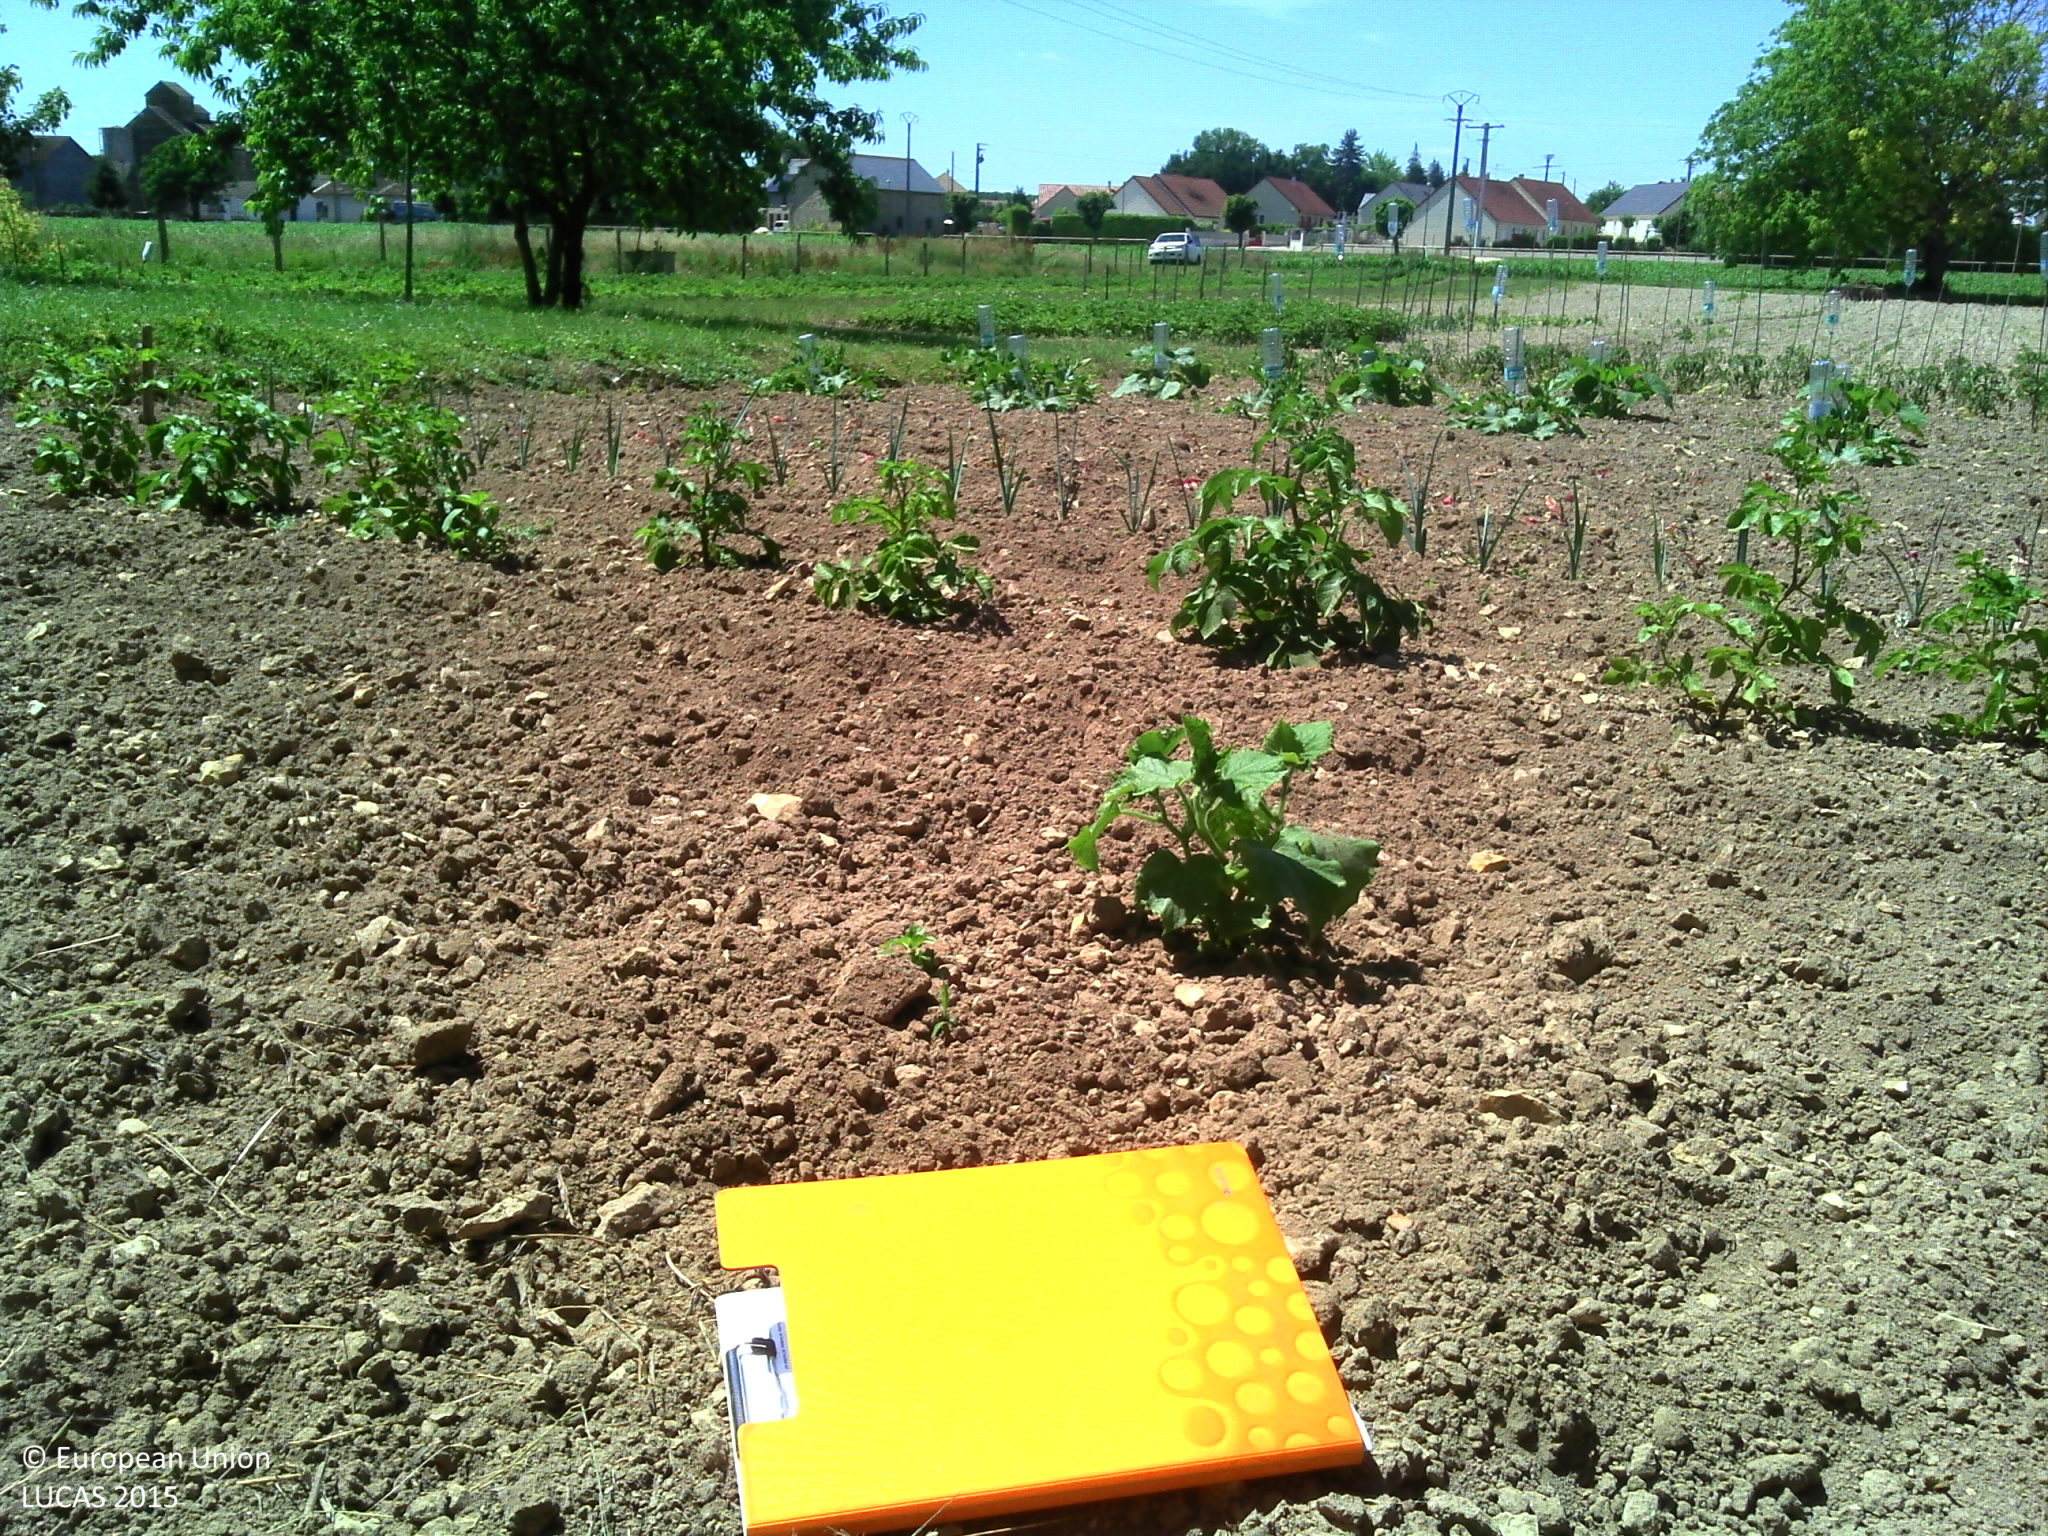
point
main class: Cropland
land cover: Other fresh vegetables
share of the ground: > 75 %
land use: Kitchen garden
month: June
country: FR
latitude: 47.1270
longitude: 2.6247
